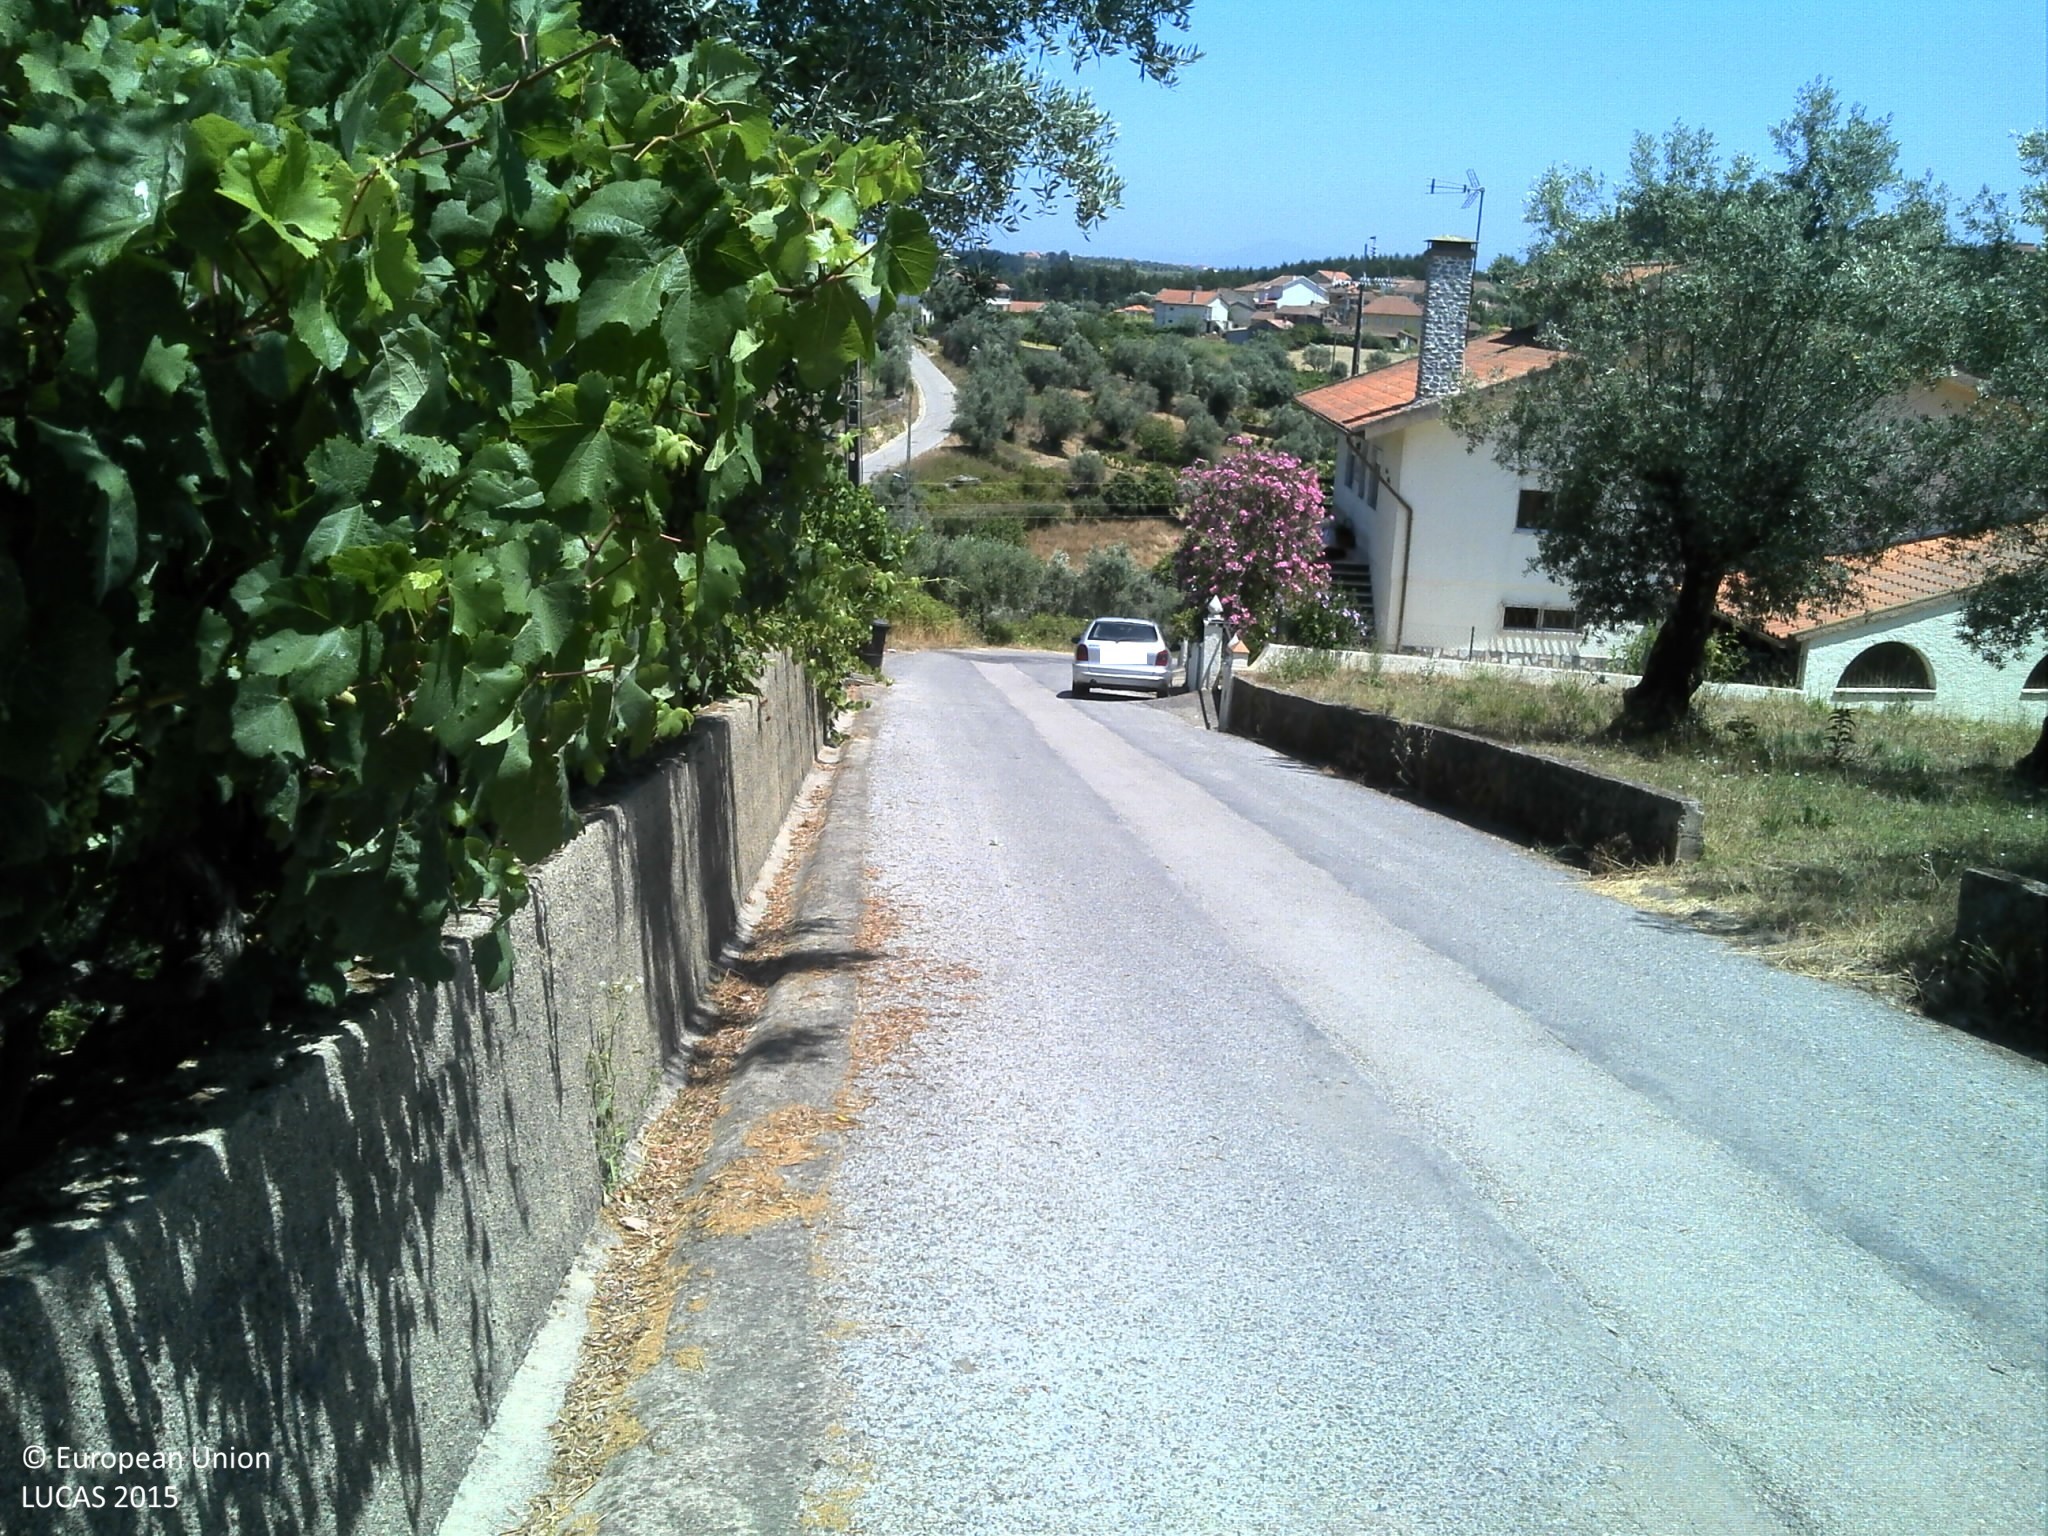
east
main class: Cropland
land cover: Olive groves
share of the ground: 10 - 25 %
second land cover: Grassland without tree/shrub cover
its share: 50 - 75 %
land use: Agriculture (excluding fallow land and kitchen gardens)
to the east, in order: Olive groves; Grassland without tree/shrub cover; Vineyards; Dry stone walls; Olive groves; Dry stone walls; Spontaneously vegetated surfaces; Vineyards; Dry stone walls; Spontaneously vegetated surfaces; Abandoned hedges; Vineyards; Dry stone walls; Spontaneously vegetated surfaces; Abandoned hedges; Vineyards; Dry stone walls; Spontaneously vegetated surfaces; Artificial constructions in urban areas; Other bare soil; Electric lines; Other bare soil; Vineyards; Other root crops; Vineyards; Artificial constructions in urban areas; Shrubland without tree cover; Paved roads, cycling and walking lanes; Olive groves; Spontaneously vegetated surfaces; Vineyards; Olive groves
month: July
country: PT
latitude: 40.3250
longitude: -8.1919
